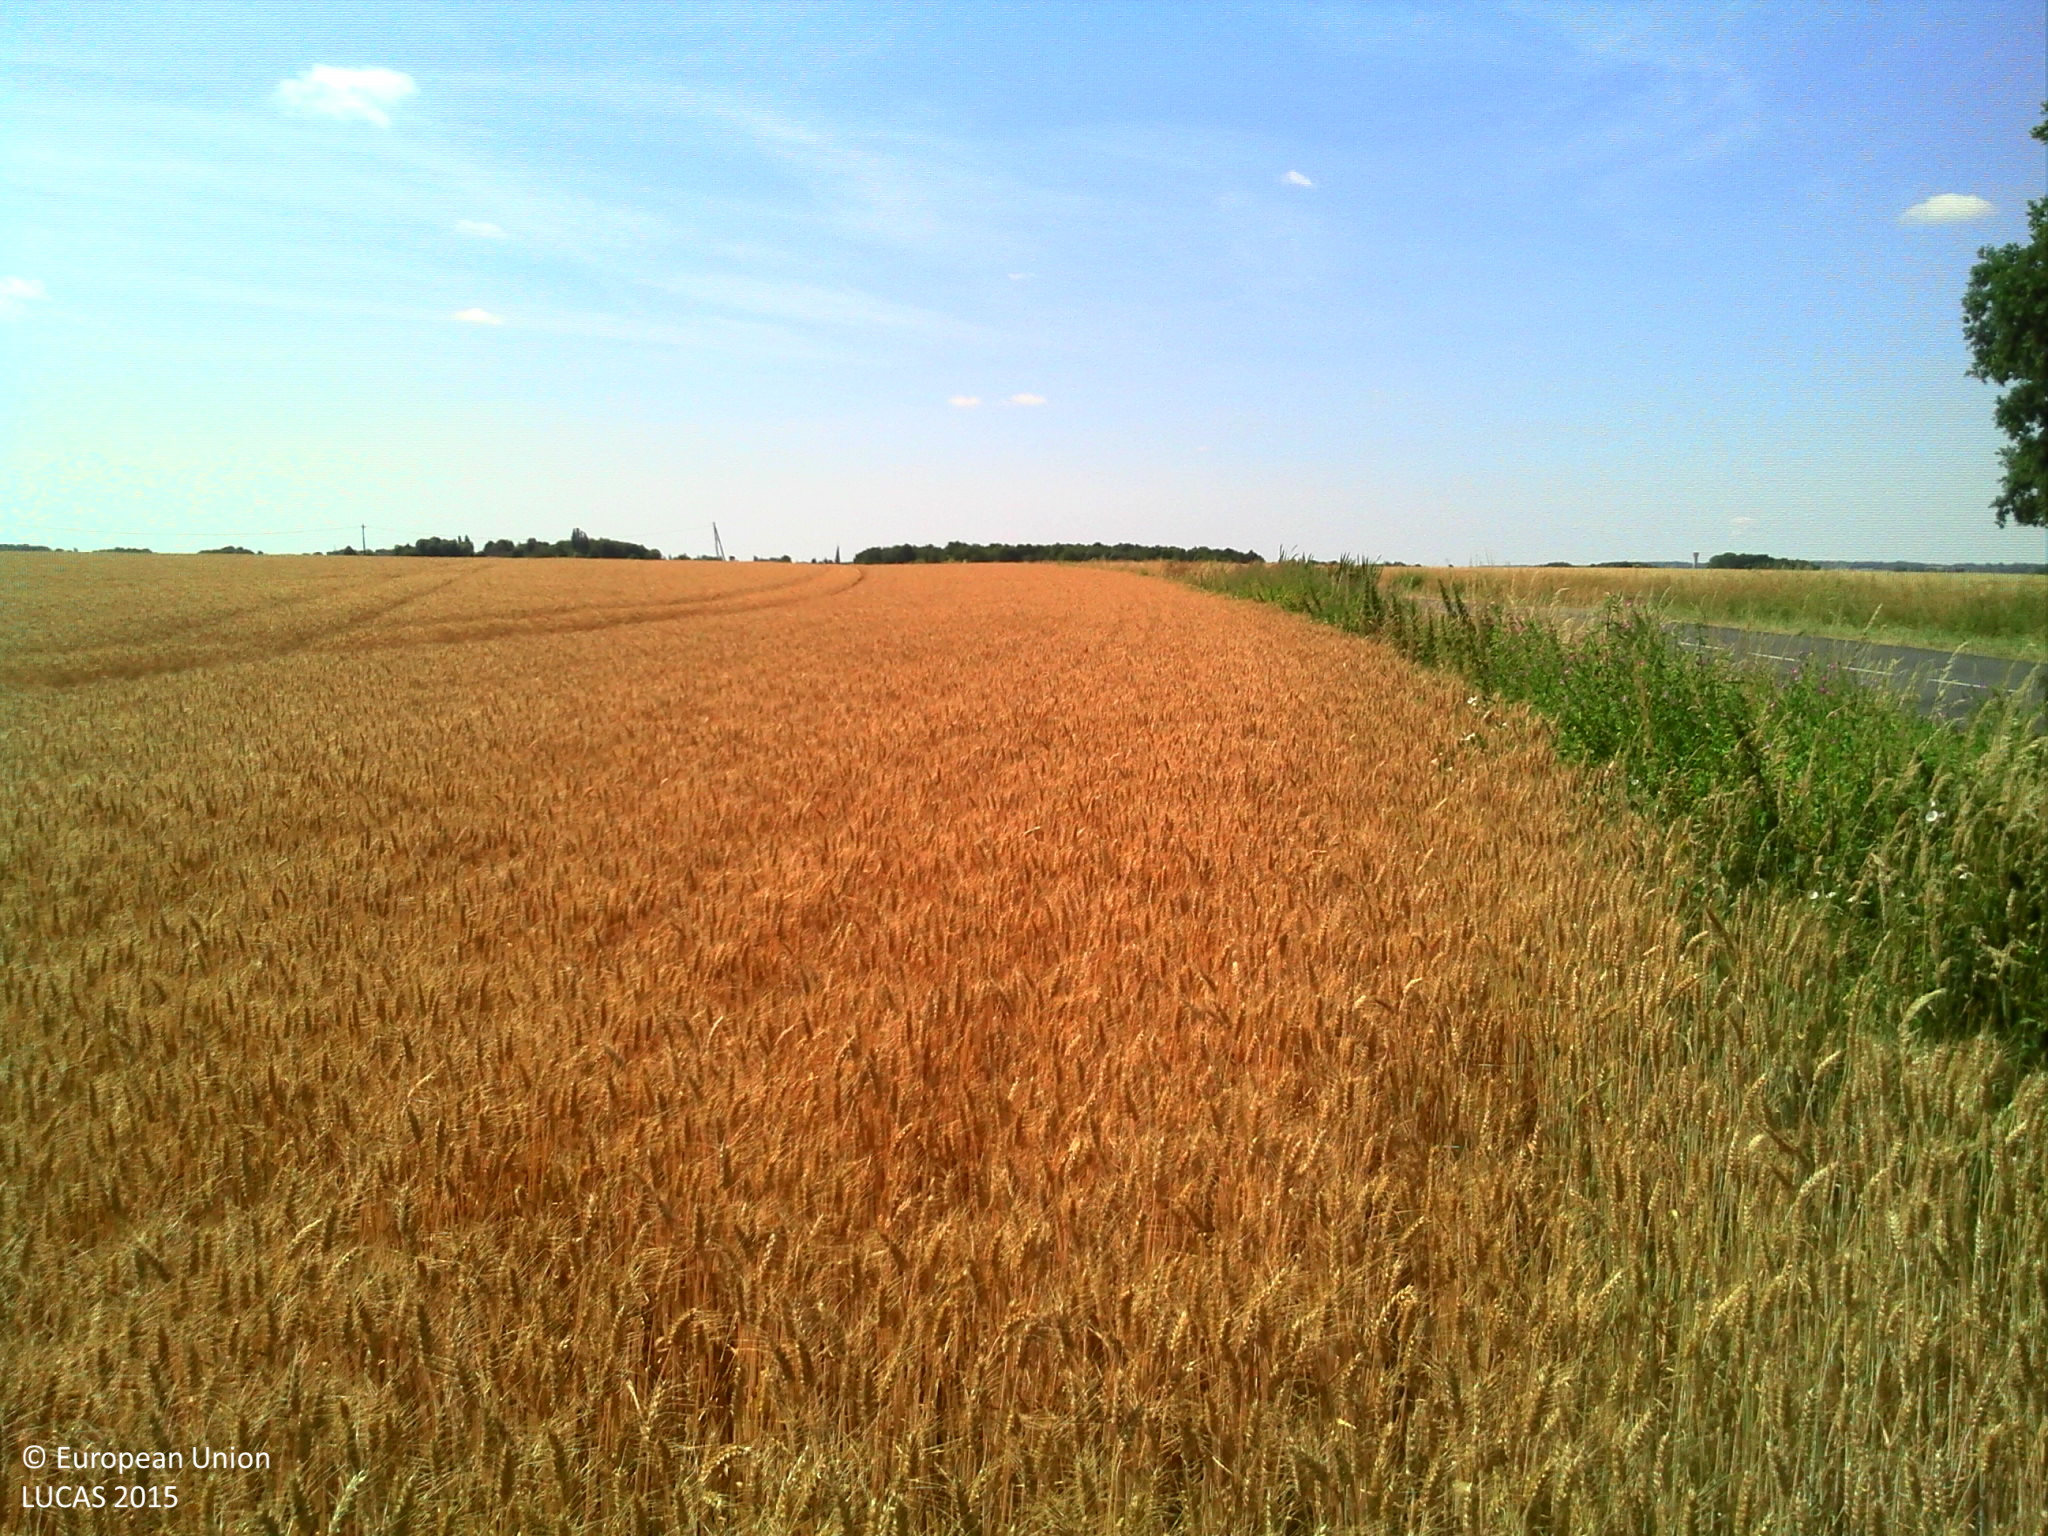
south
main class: Cropland
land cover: Common wheat
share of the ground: > 75 %
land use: Agriculture (excluding fallow land and kitchen gardens)
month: July
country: FR
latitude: 47.9871
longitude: 3.0658
